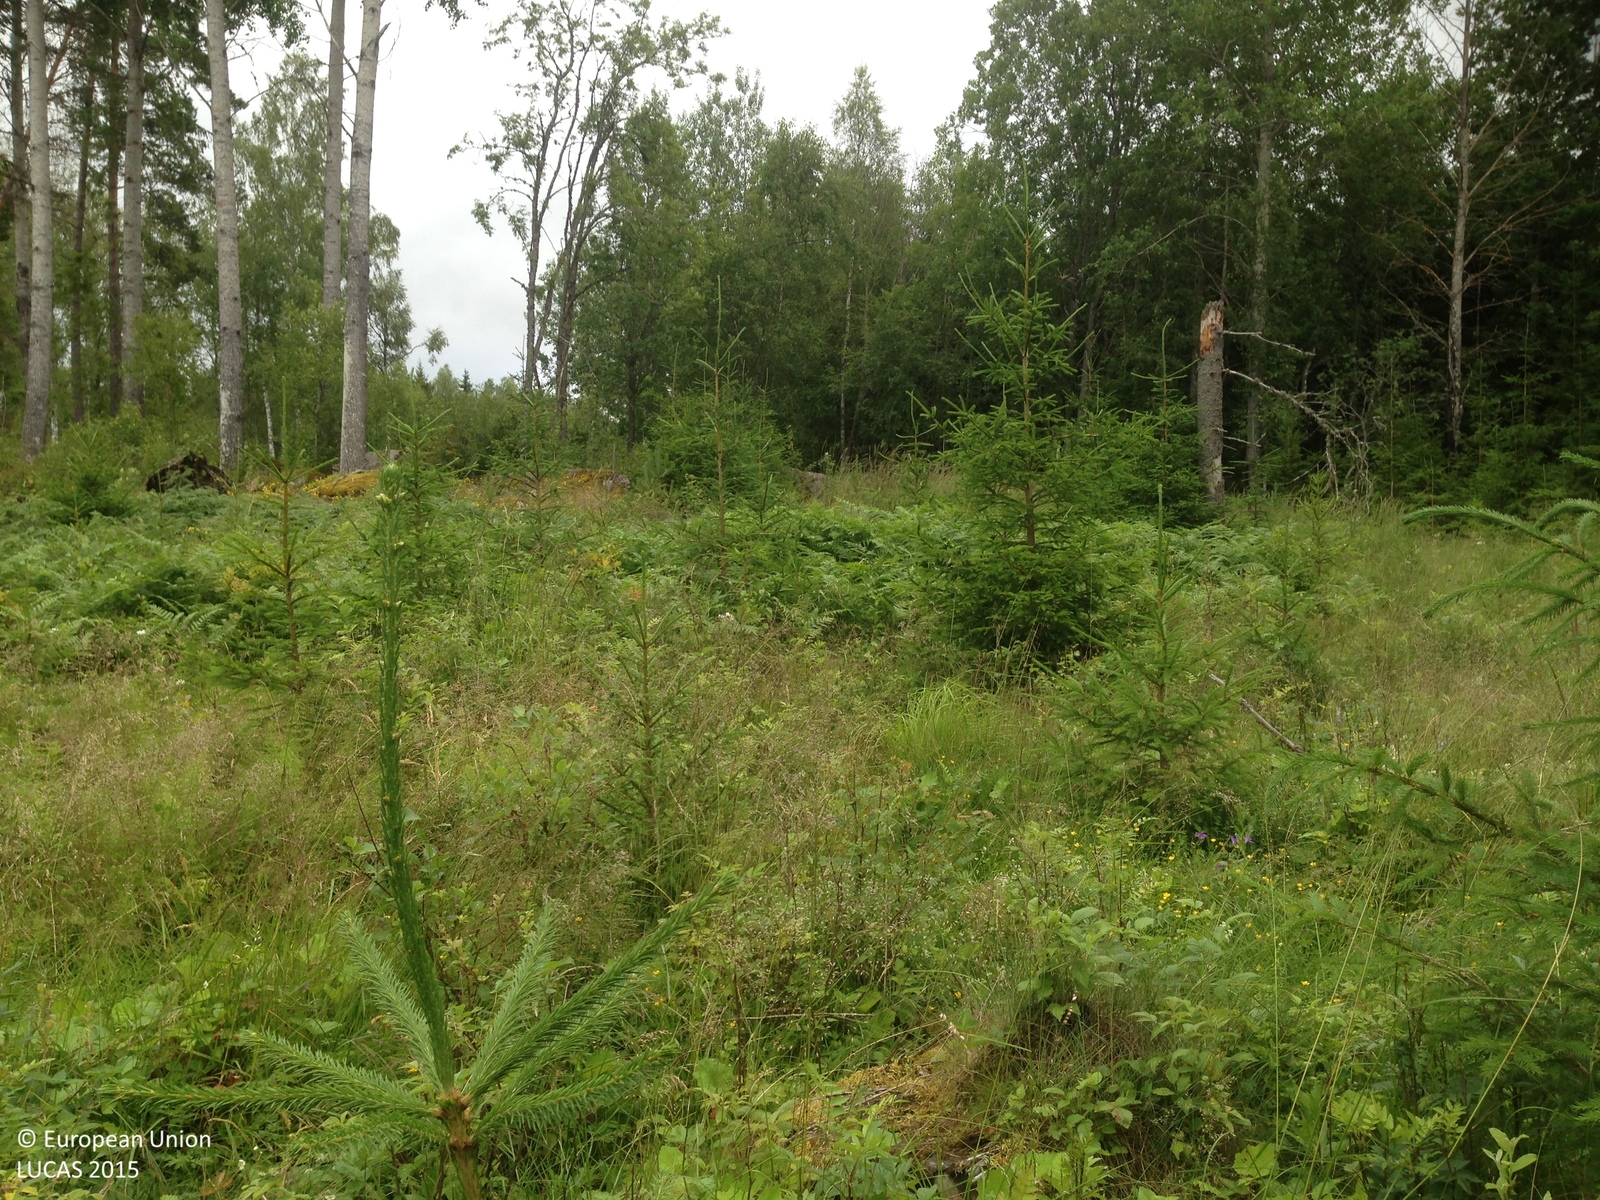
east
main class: Woodland
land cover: Spruce dominated coniferous woodland
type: boreal forest
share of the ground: 25 - 50 %
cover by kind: coniferous forest trees 40 %, herbaceous plants 25 %, lichens and mosses 25 %, broadleaved forest trees 10 %
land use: Forestry
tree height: < 5 m
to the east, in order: Spruce dominated coniferous woodland; Spruce dominated mixed woodland; Ditches and canals; Spruce dominated mixed woodland; Ditches and canals; Spruce dominated coniferous woodland; Ditches and canals; Spruce dominated mixed woodland; Spruce dominated coniferous woodland
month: July
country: SE
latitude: 59.8814
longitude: 16.9778
